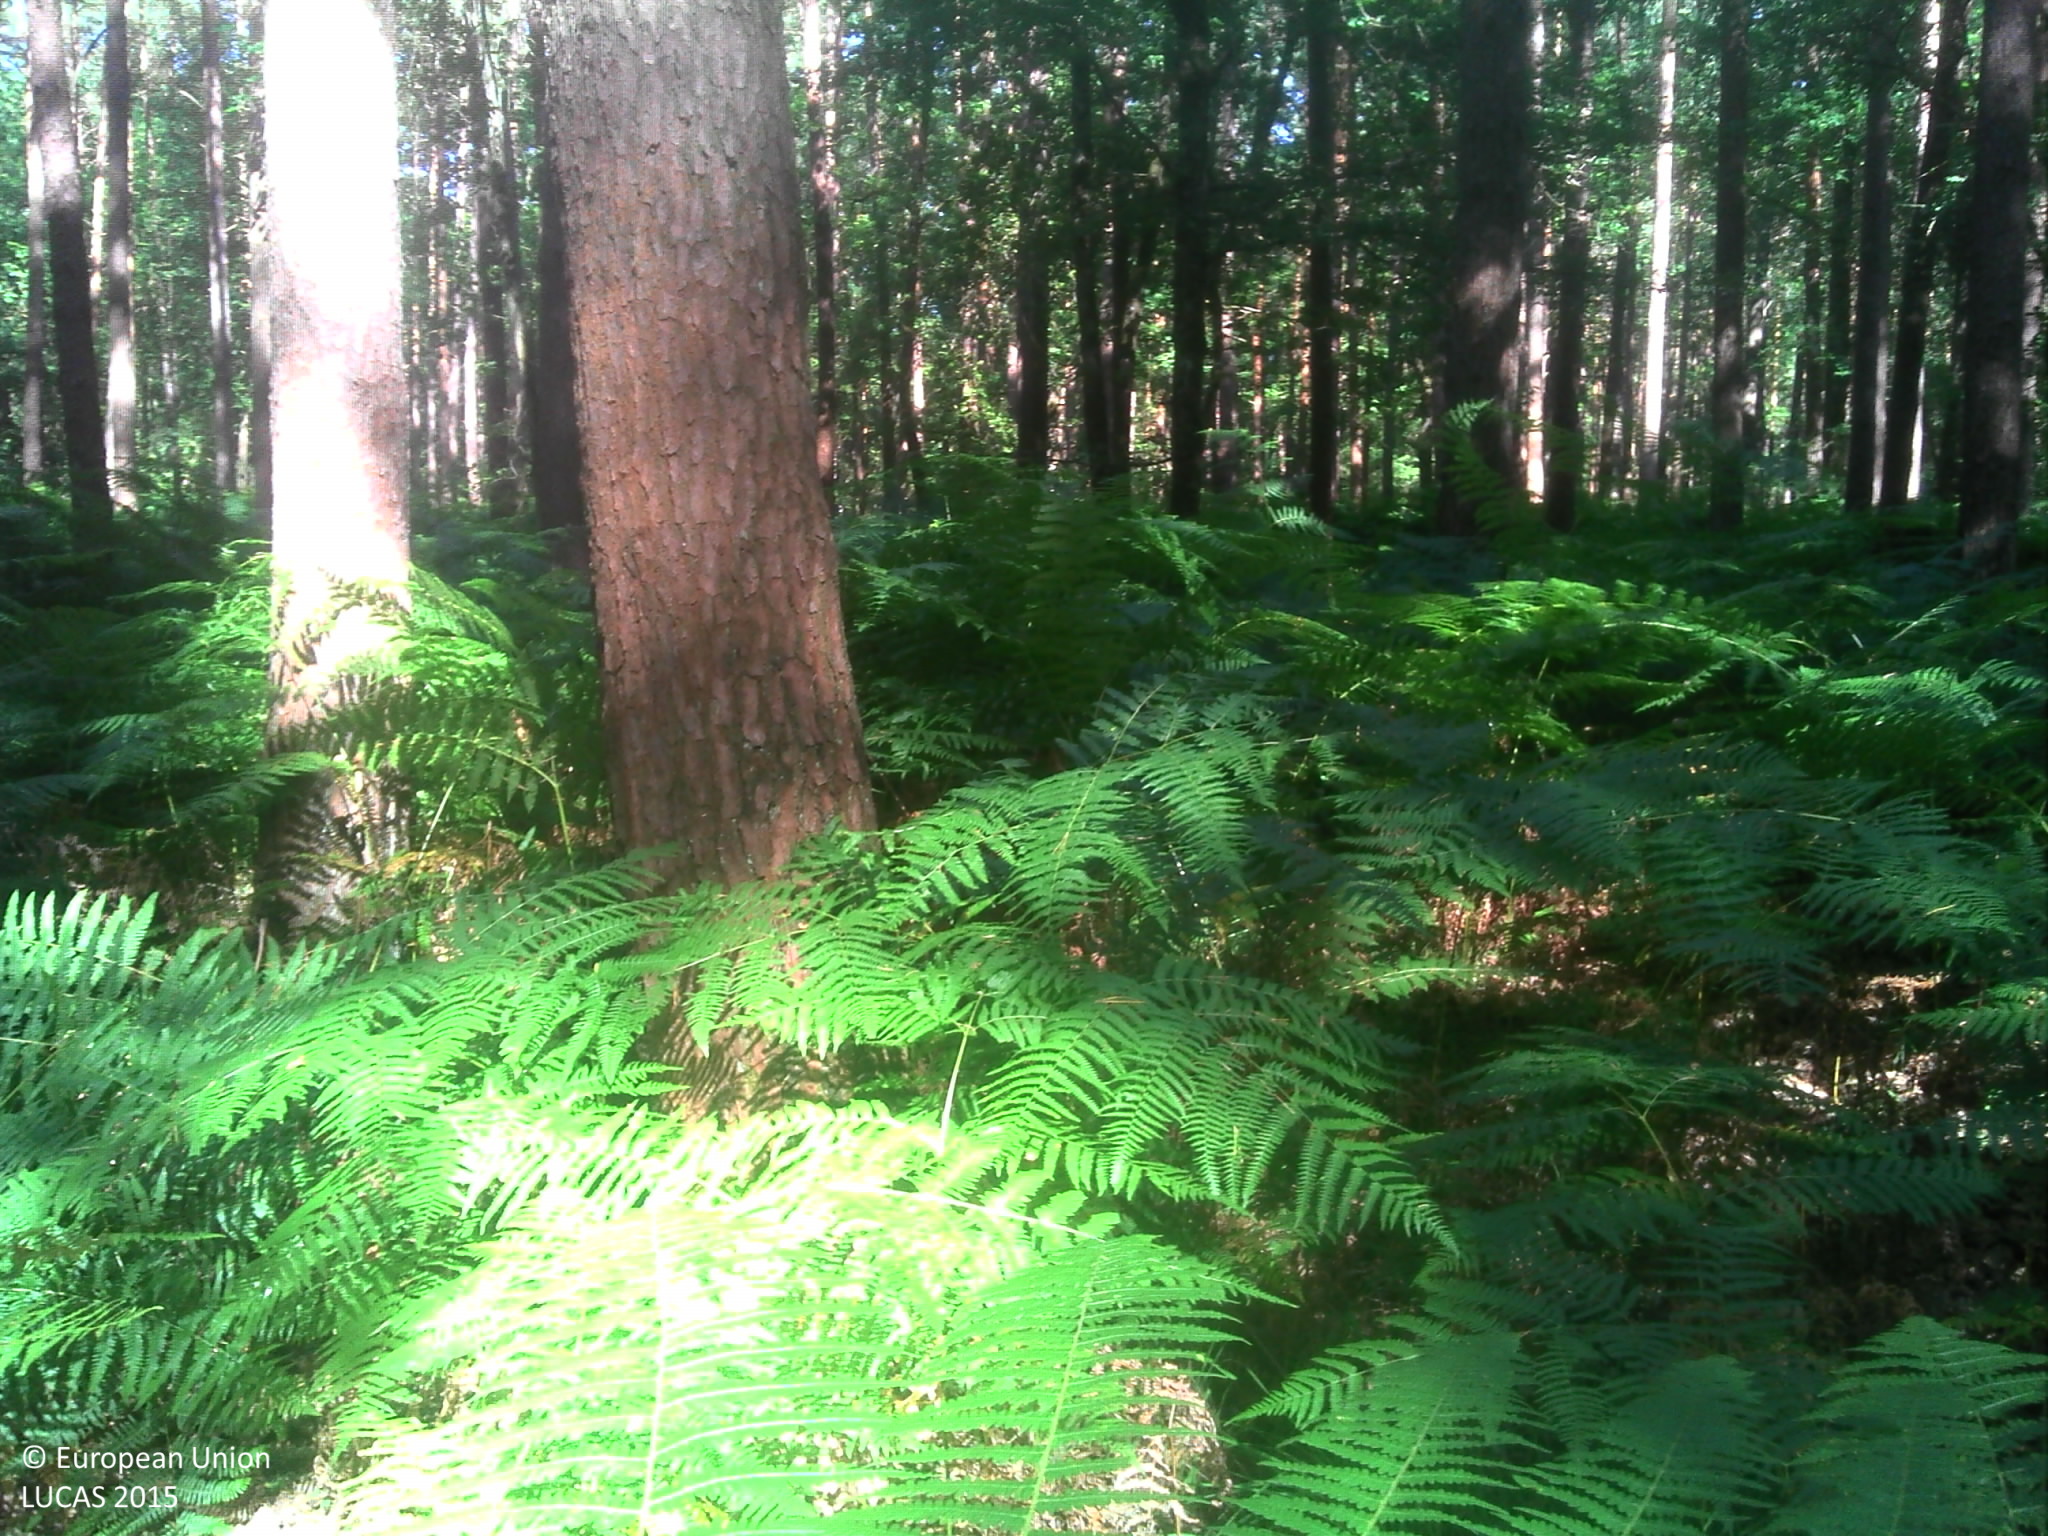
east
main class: Woodland
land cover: Pine dominated mixed woodland
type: thermophilous deciduous forest
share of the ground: > 75 %
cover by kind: herbaceous plants 40 %, unconsolidated bare surface 35 %, coniferous forest trees 15 %, broadleaved forest trees 10 %
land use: Forestry
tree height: > 5 m
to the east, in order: Pine dominated mixed woodland; Inland fresh water bodies; Pine dominated mixed woodland
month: June
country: FR
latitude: 47.3101
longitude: 1.4280
